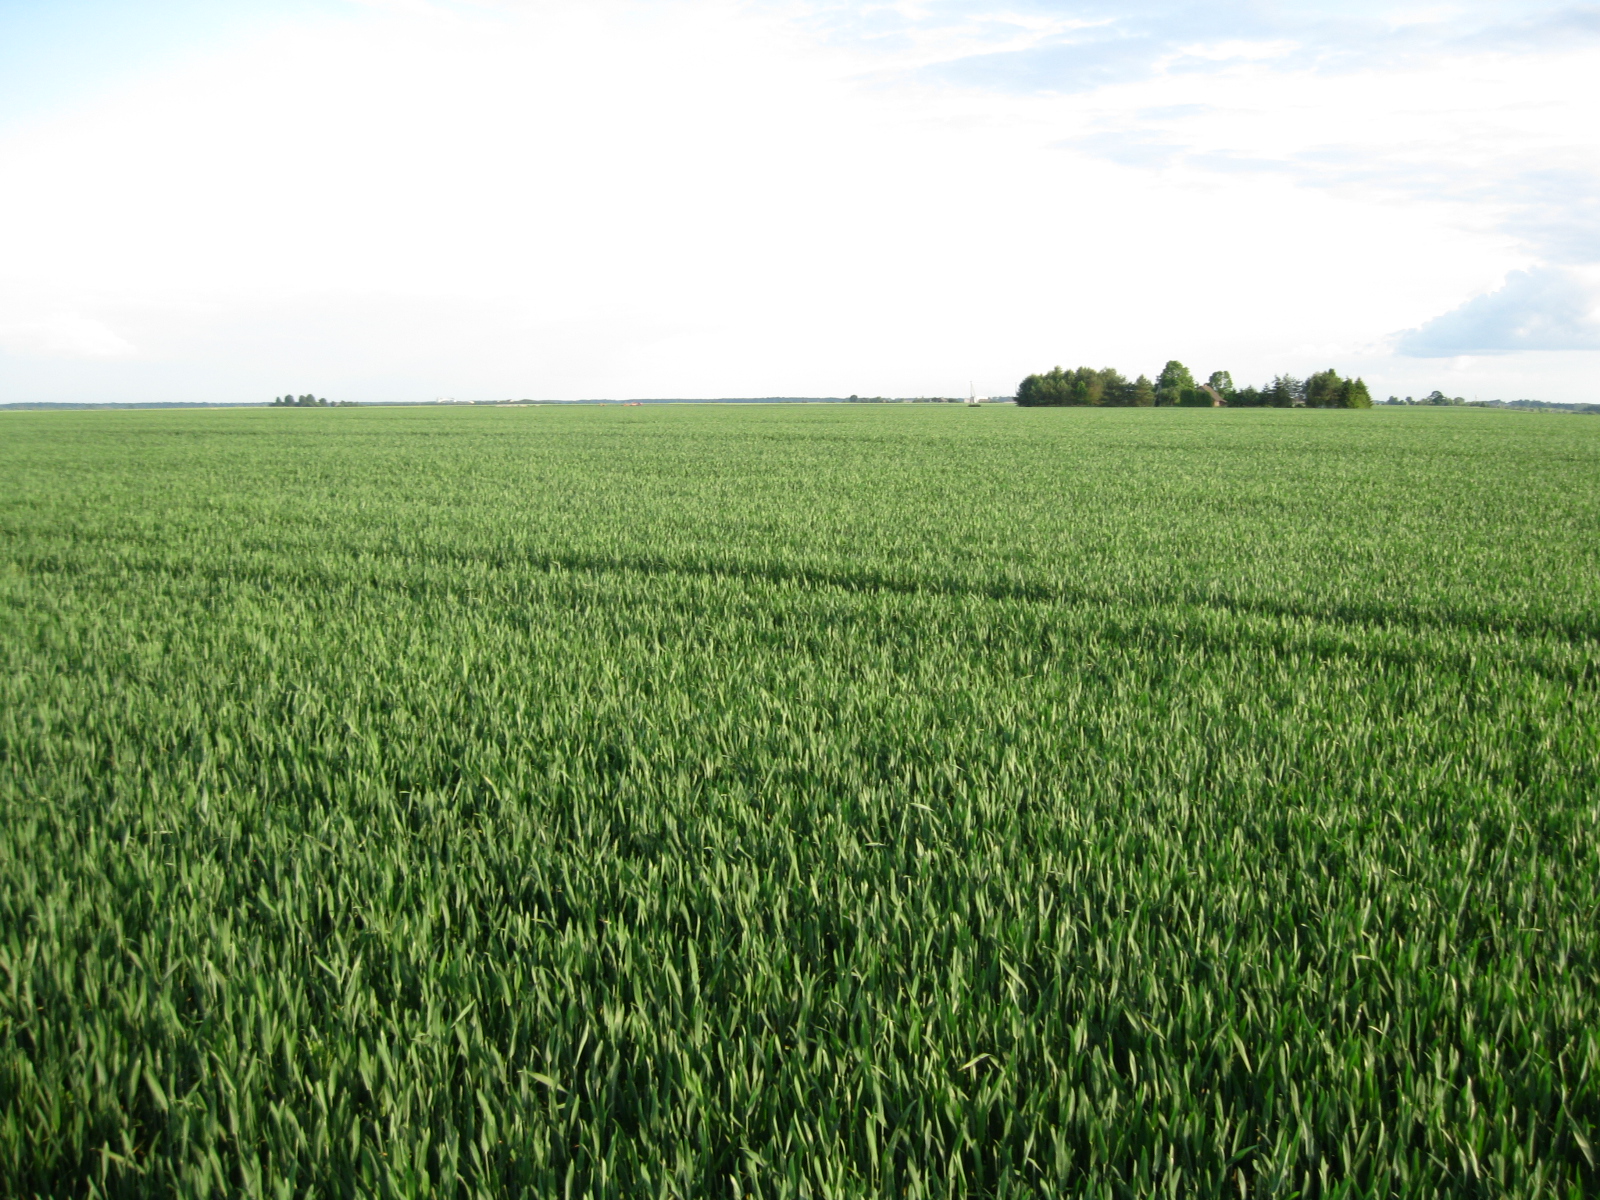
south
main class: Cropland
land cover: Common wheat
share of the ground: > 75 %
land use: Agriculture (excluding fallow land and kitchen gardens)
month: June
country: LT
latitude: 55.1575
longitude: 23.8514
